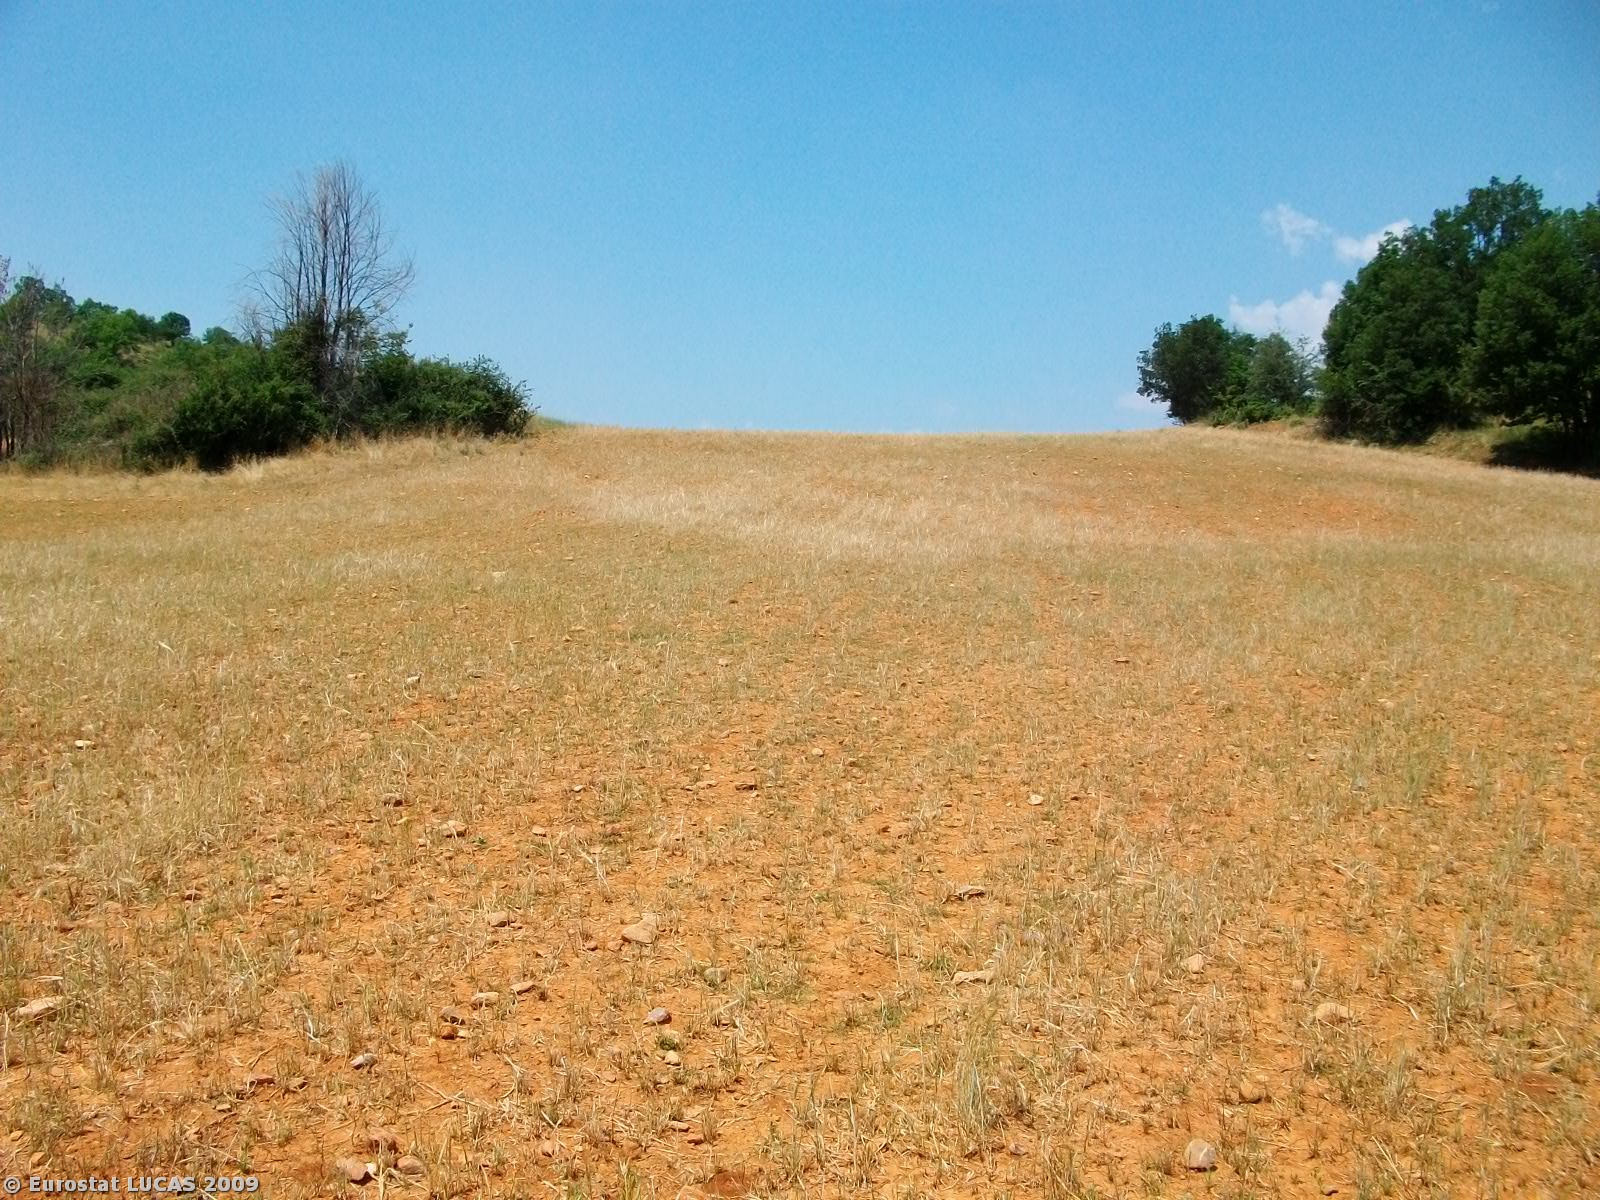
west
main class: Grassland
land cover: Grassland without tree/shrub cover
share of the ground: 50 - 75 %
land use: Agriculture (excluding fallow land and kitchen gardens)
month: July
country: GR
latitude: 40.6771
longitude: 21.8630
